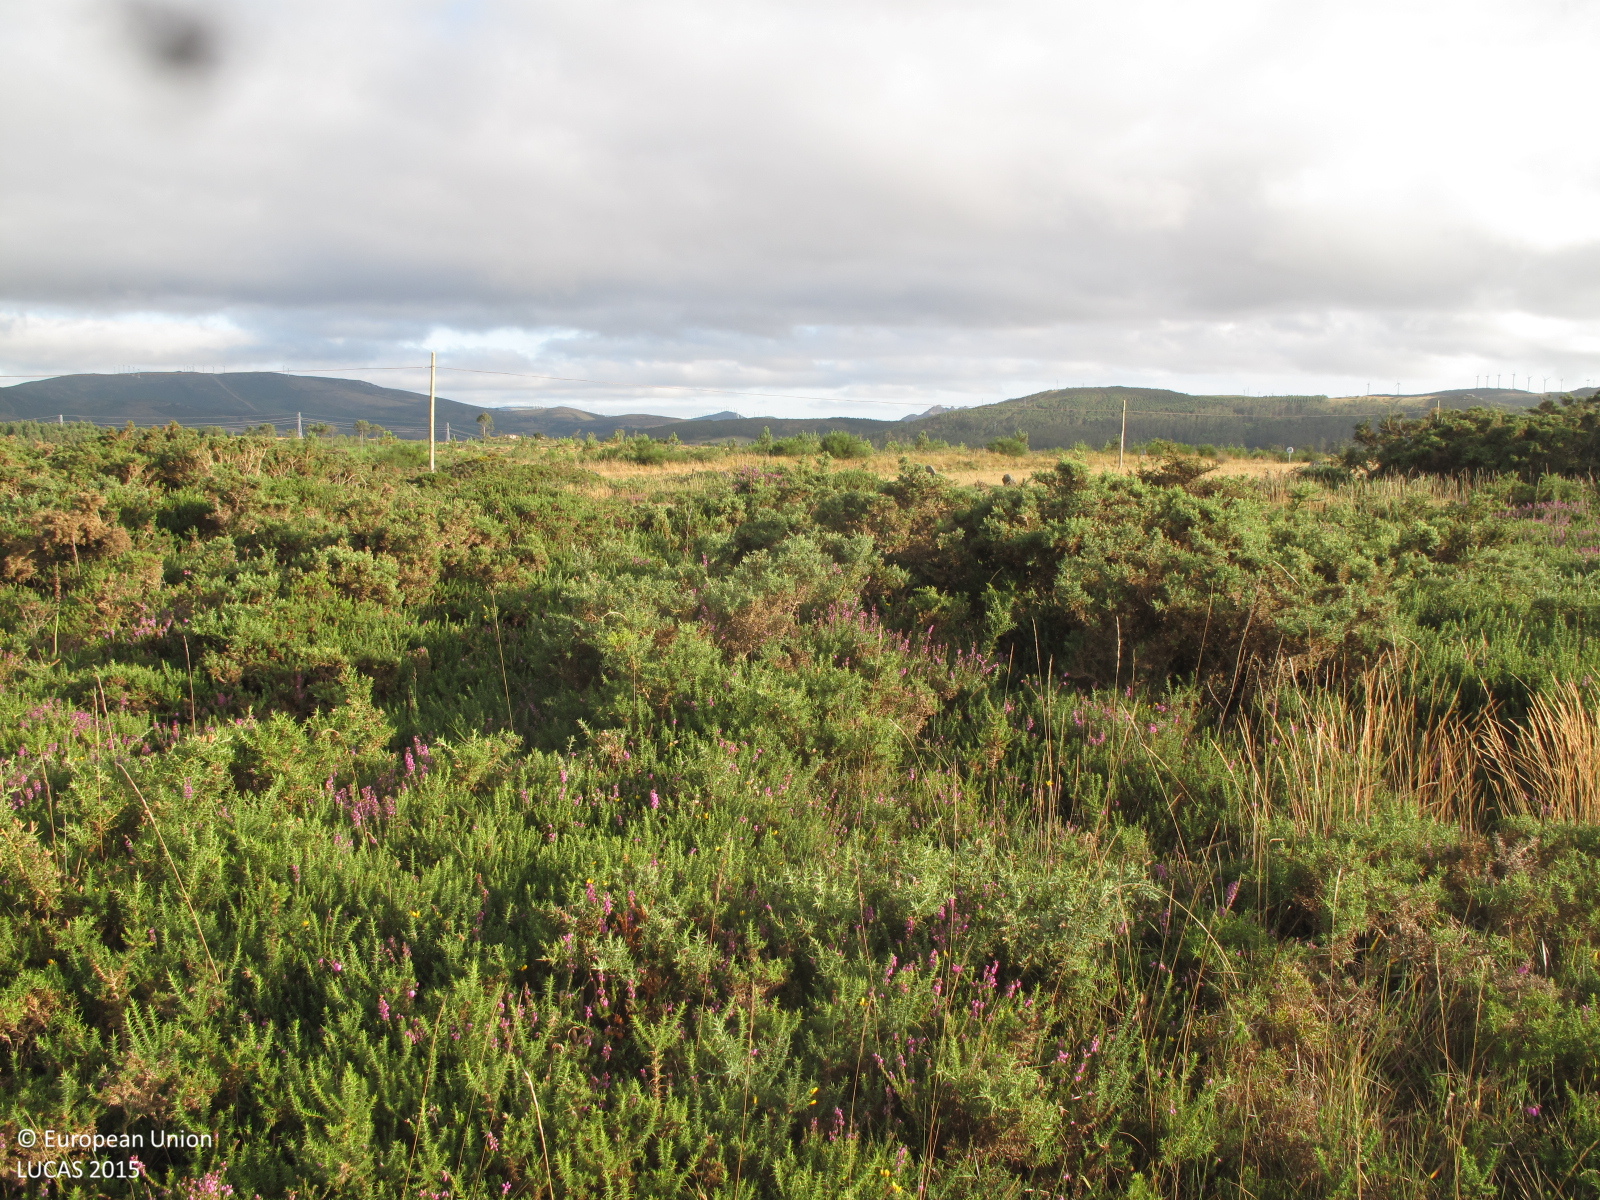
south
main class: Shrubland
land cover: Shrubland without tree cover
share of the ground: > 75 %
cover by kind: shrubs 80 %, herbaceous plants 20 %
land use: Abandoned areas
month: July
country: ES
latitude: 42.9822
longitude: -9.0952
